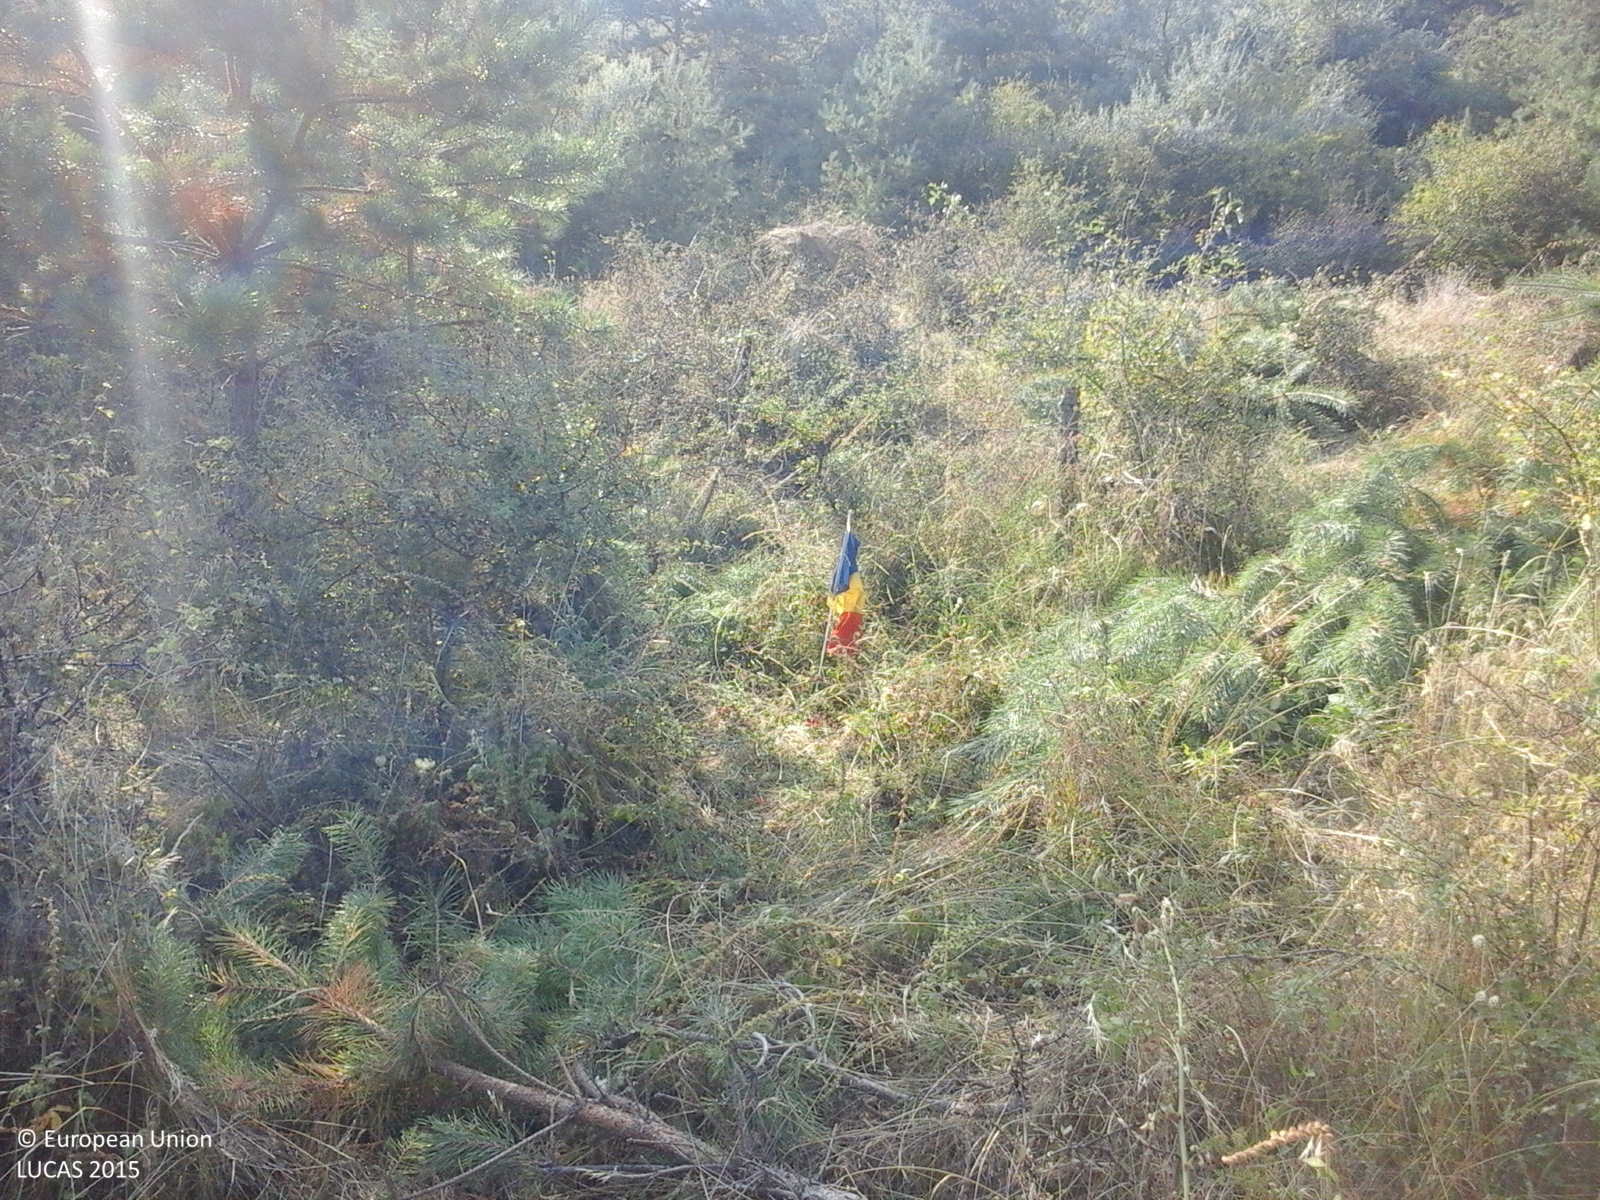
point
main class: Grassland
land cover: Grassland with sparse tree/shrub cover
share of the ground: > 75 %
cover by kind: herbaceous plants 85 %, shrubs 10 %, broadleaved forest trees 5 %
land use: Forestry
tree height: < 5 m
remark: Clear cut
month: September
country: RO
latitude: 47.1226
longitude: 24.1482
